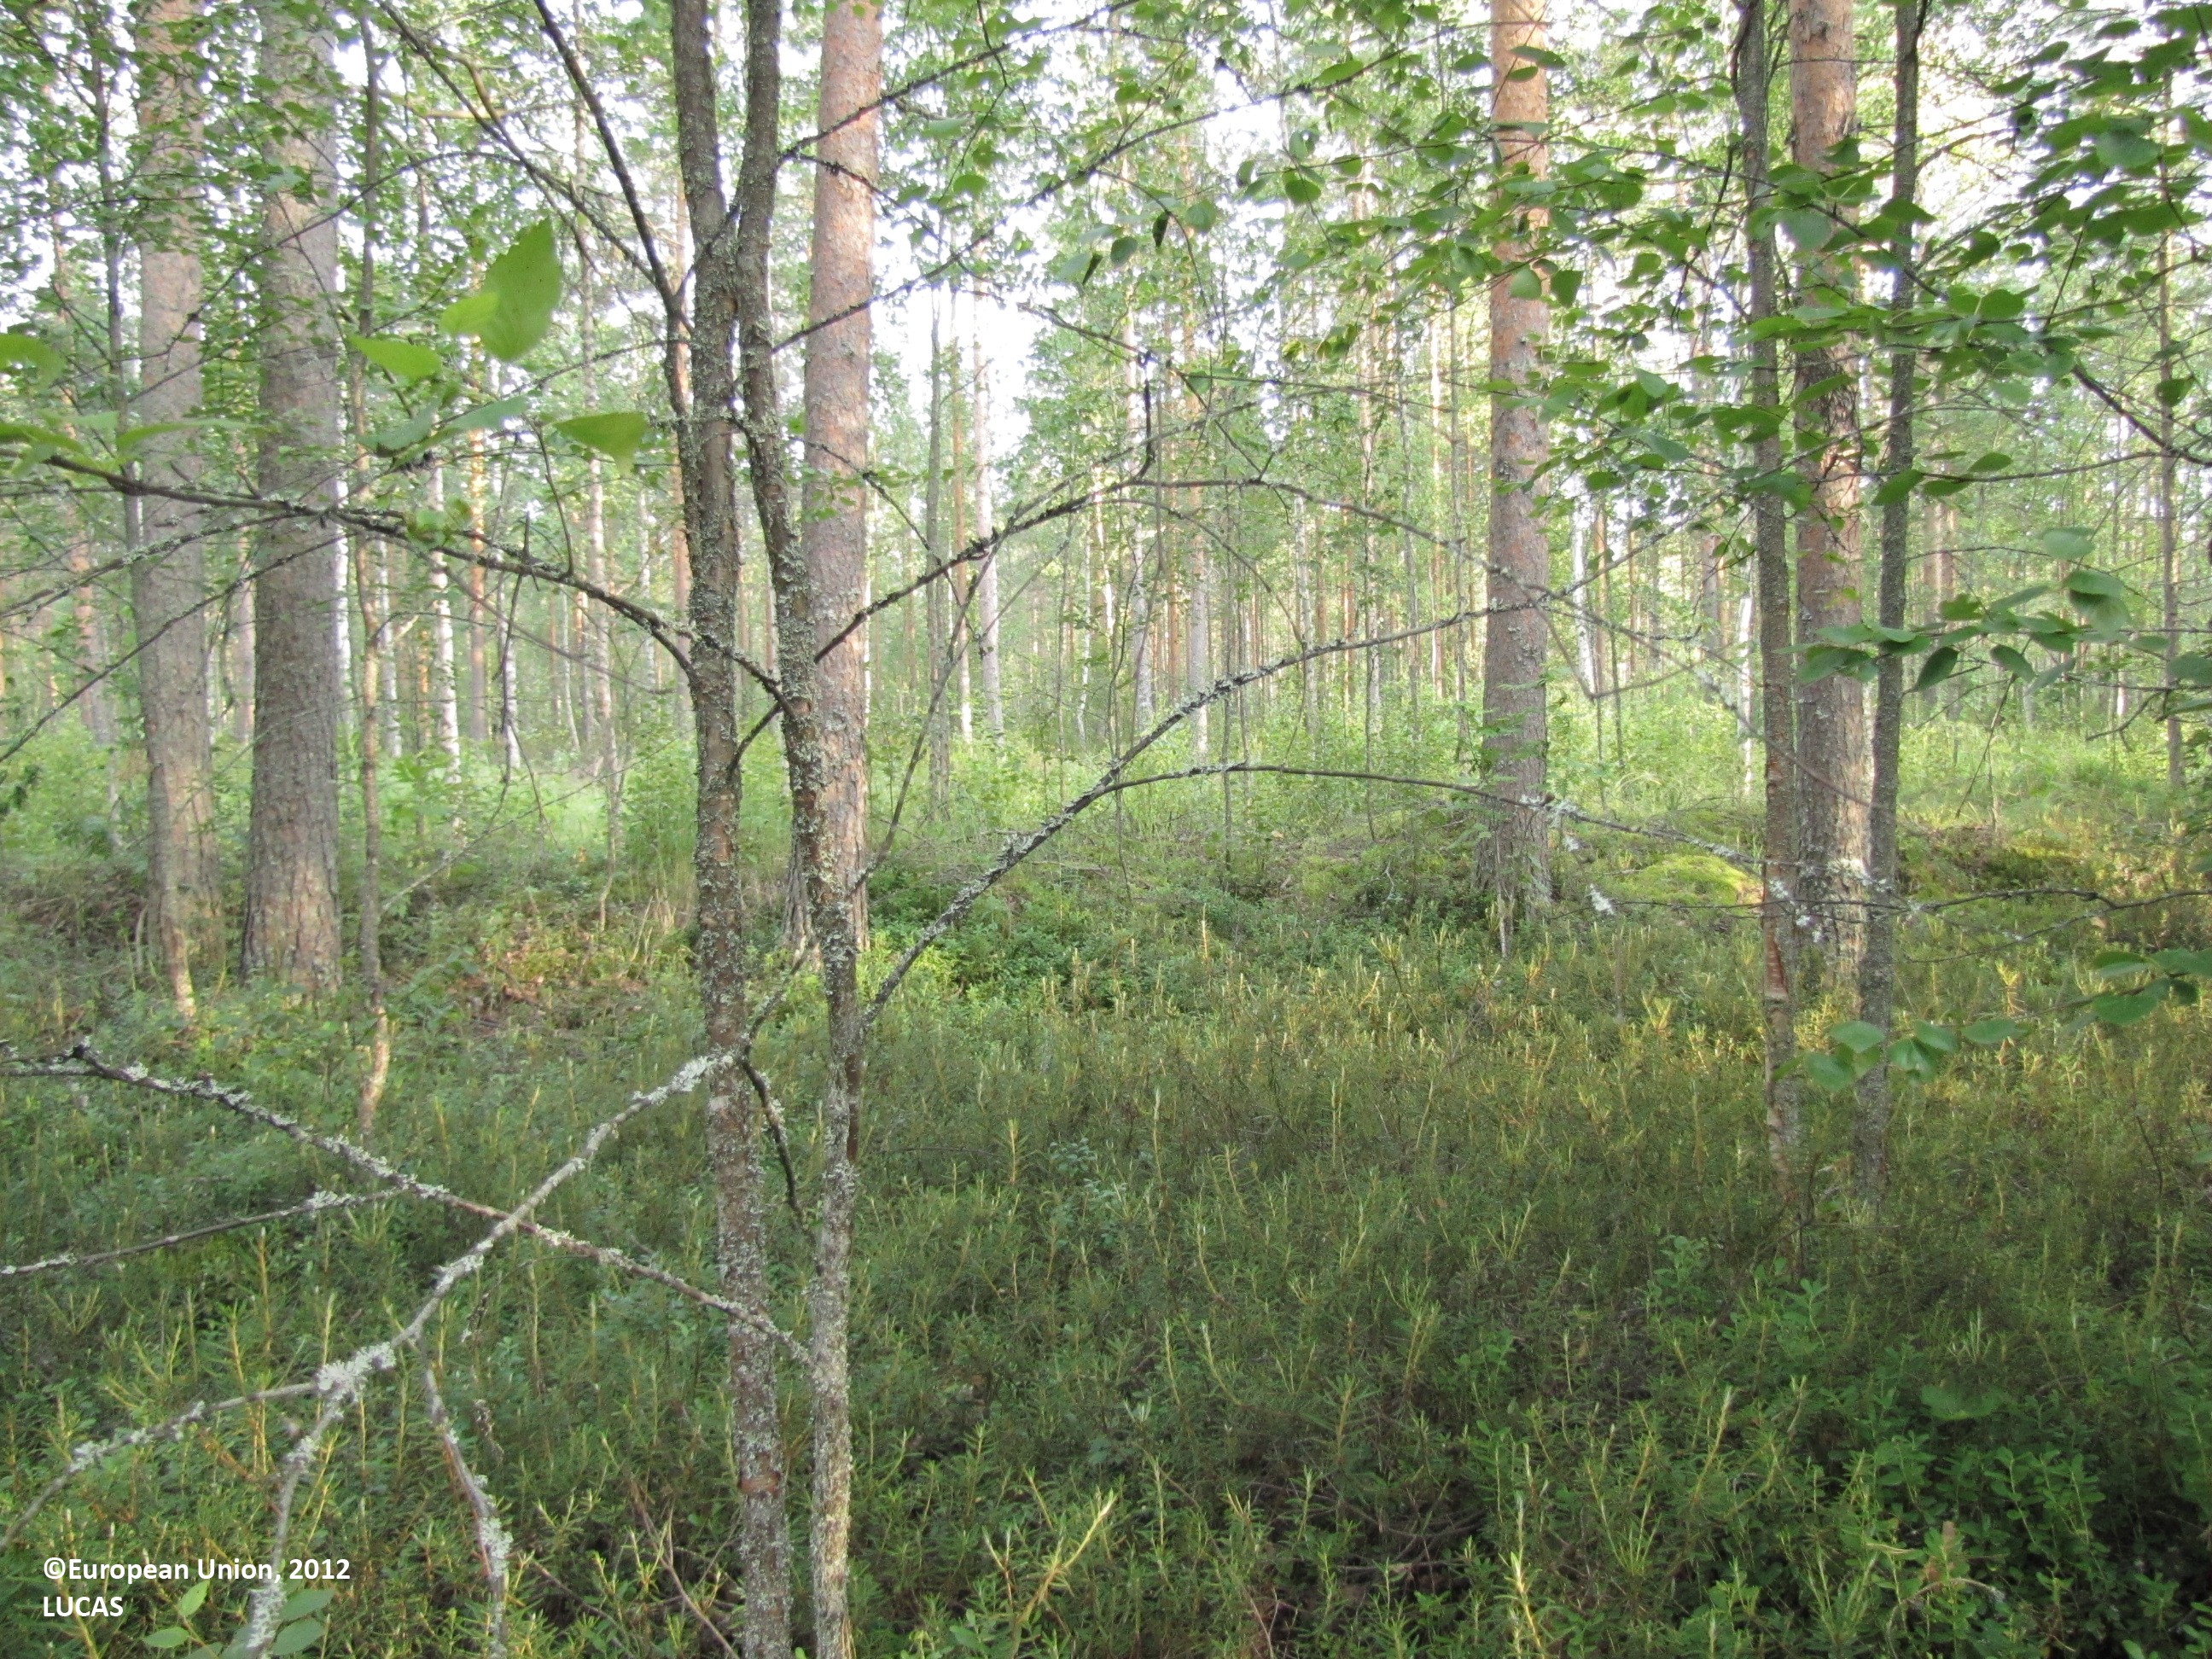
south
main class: Woodland
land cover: Pine dominated mixed woodland
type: mire and swamp forests
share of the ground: > 75 %
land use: Forestry
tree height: > 5 m
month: July
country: FI
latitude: 62.5925
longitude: 23.4473
